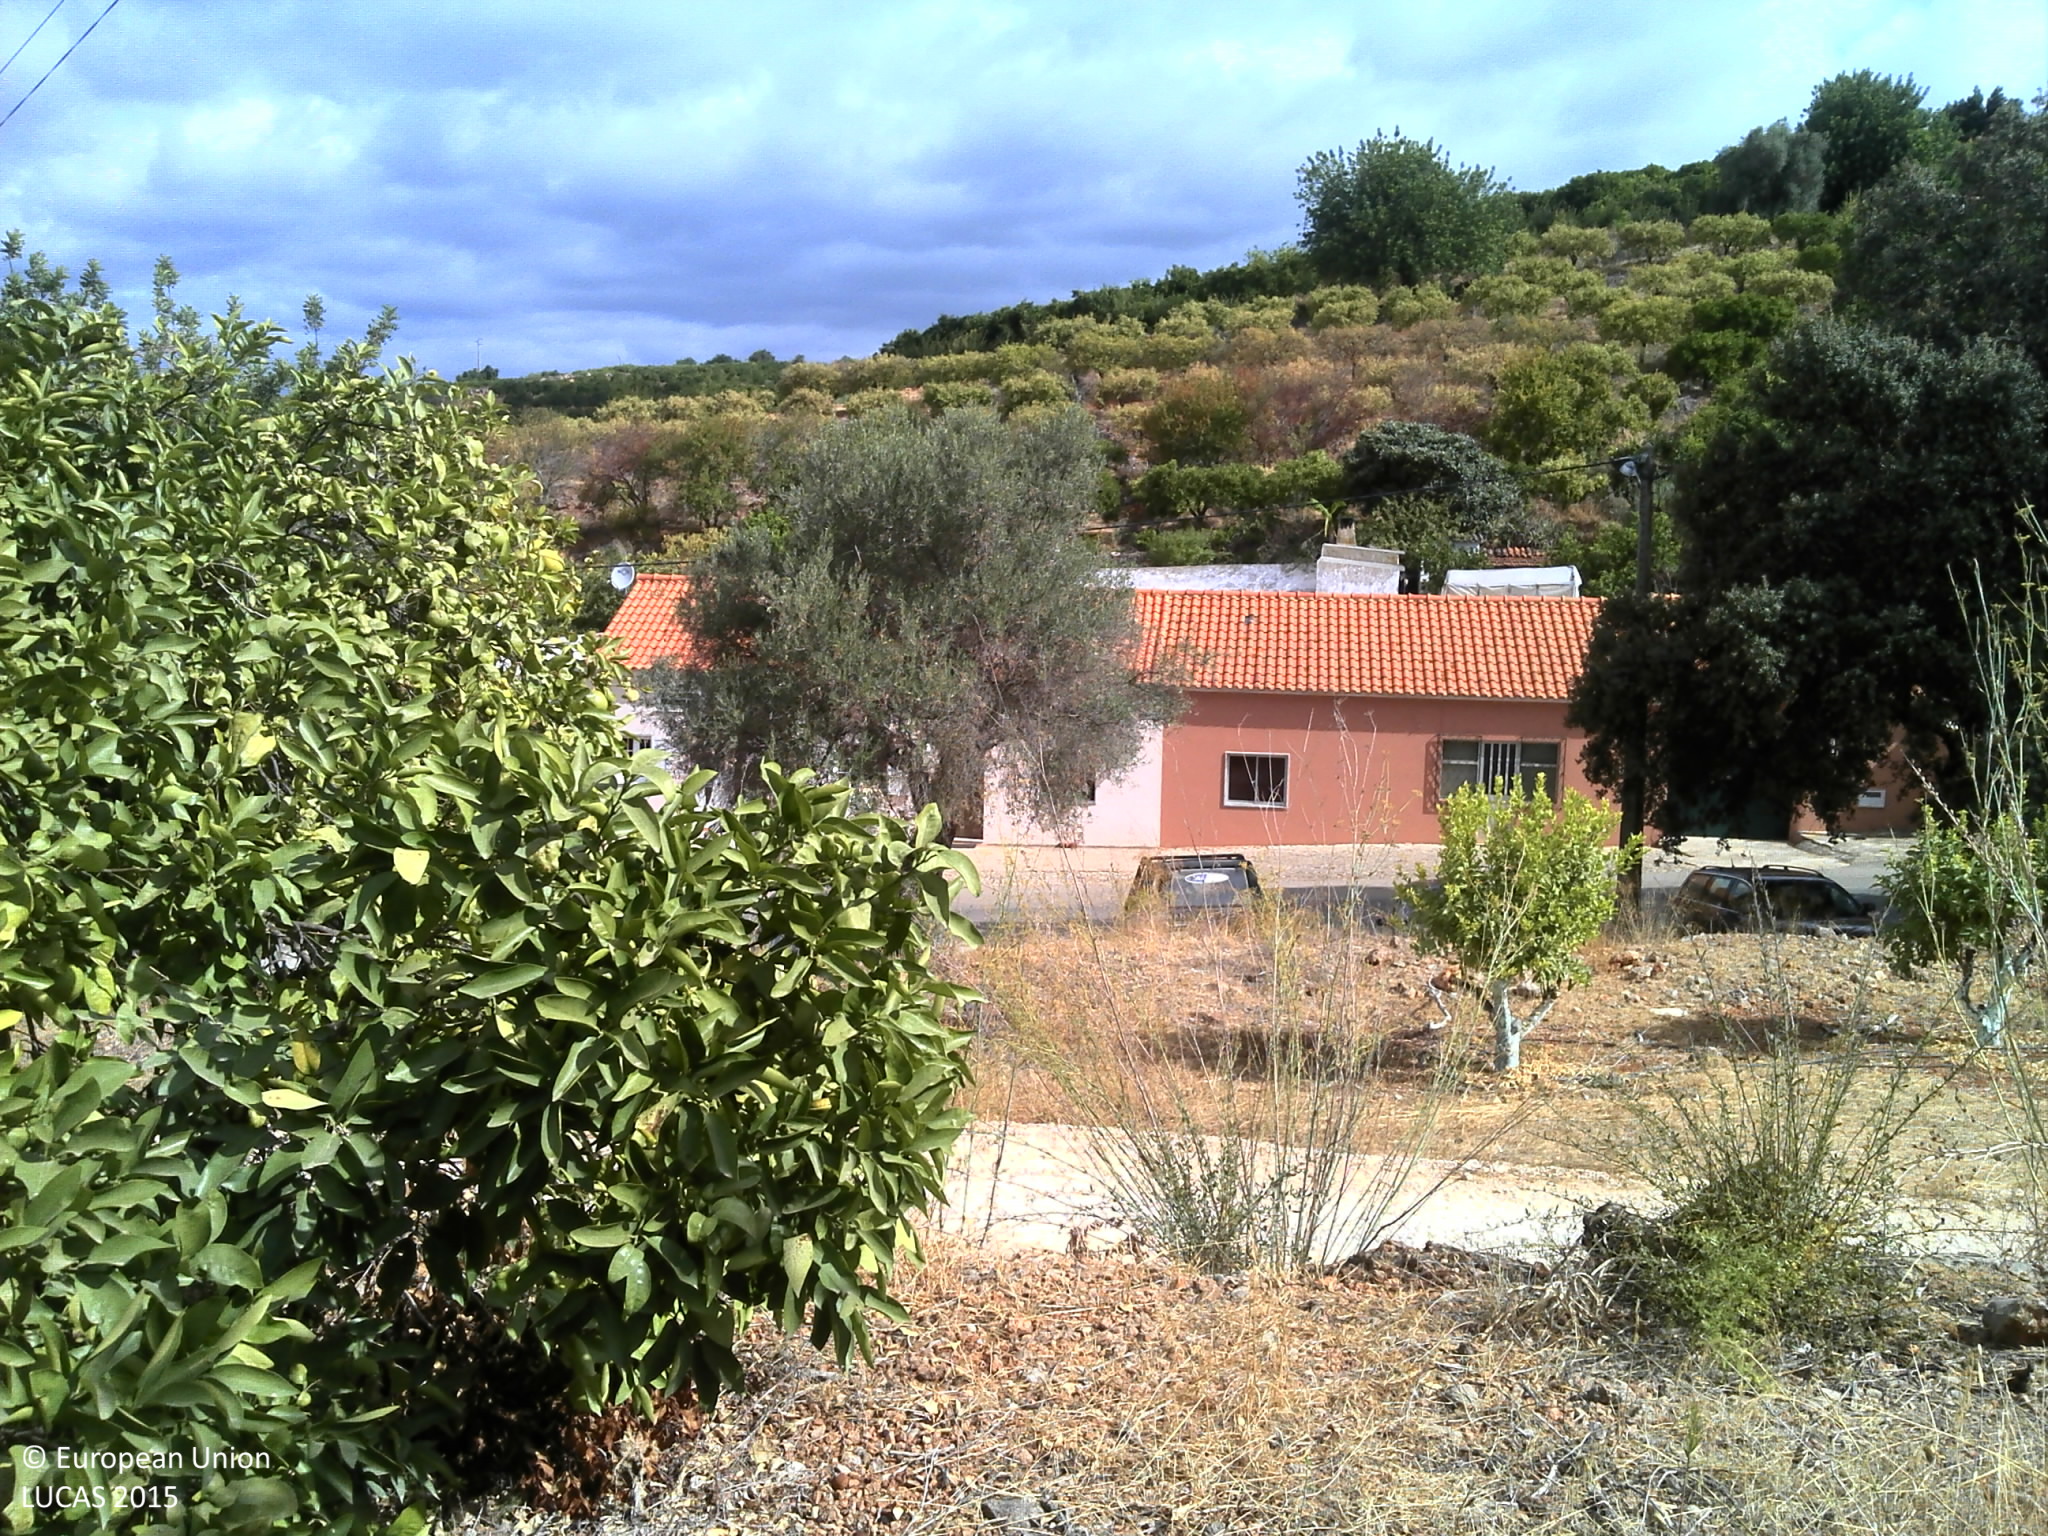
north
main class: Cropland
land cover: Other citrus fruit
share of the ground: 25 - 50 %
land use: Agriculture (excluding fallow land and kitchen gardens)
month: September
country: PT
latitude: 37.1959
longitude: -8.3981
